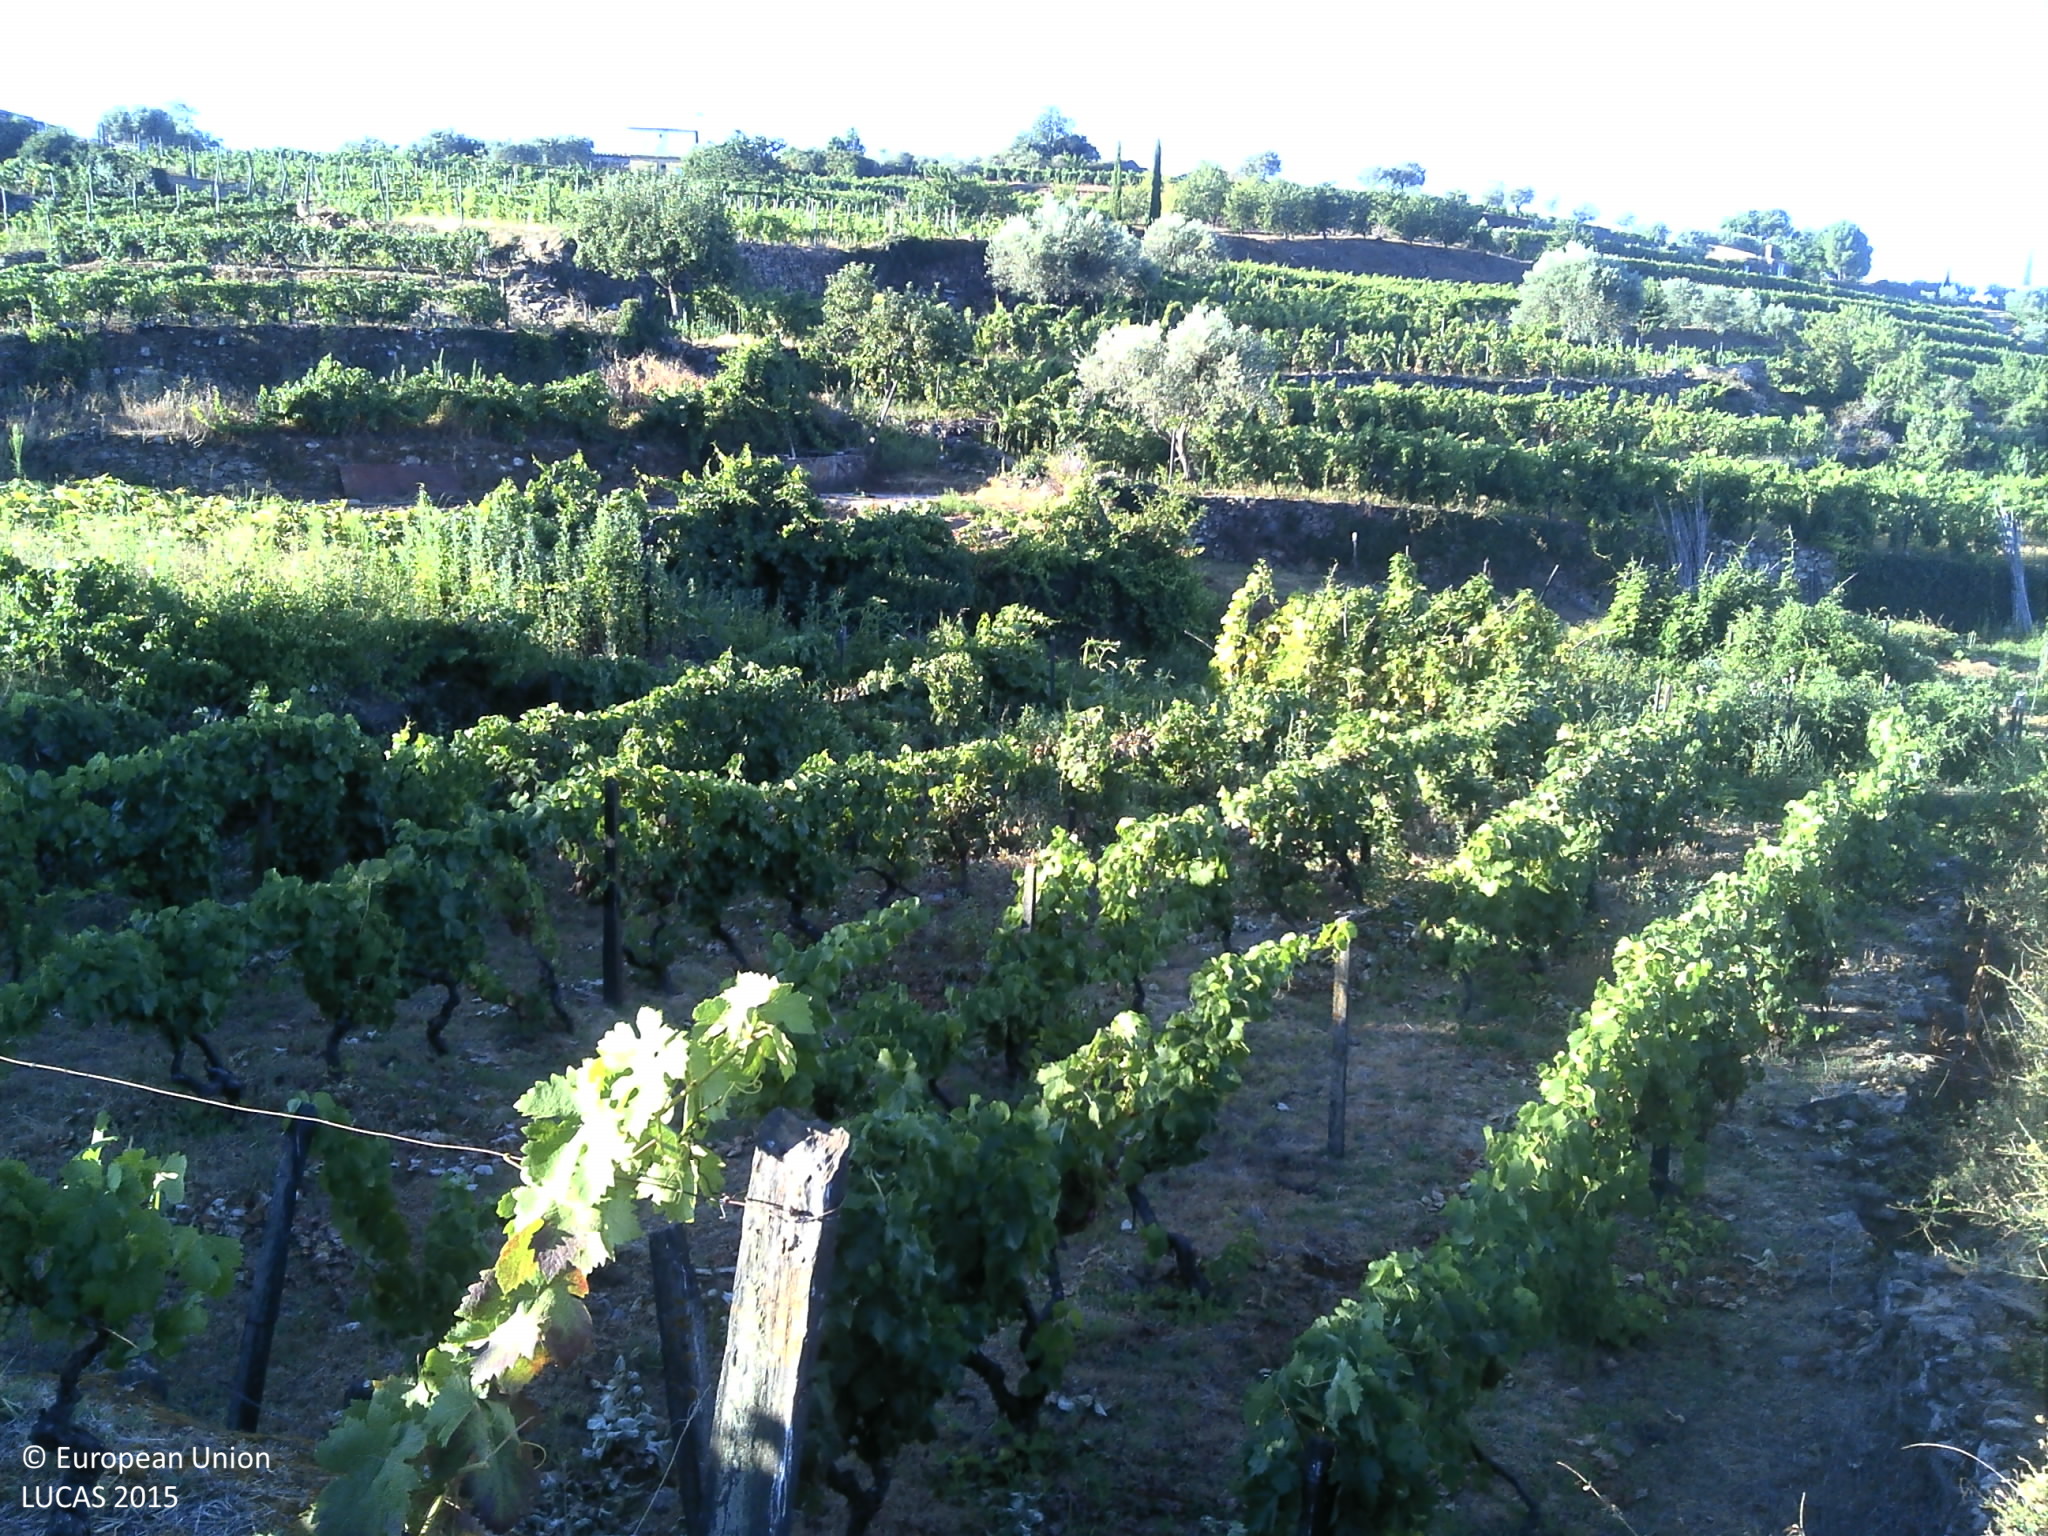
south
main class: Shrubland
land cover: Shrubland without tree cover
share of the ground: > 75 %
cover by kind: shrubs 100 %
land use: Abandoned areas
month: July
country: PT
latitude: 41.2965
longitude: -7.5244
